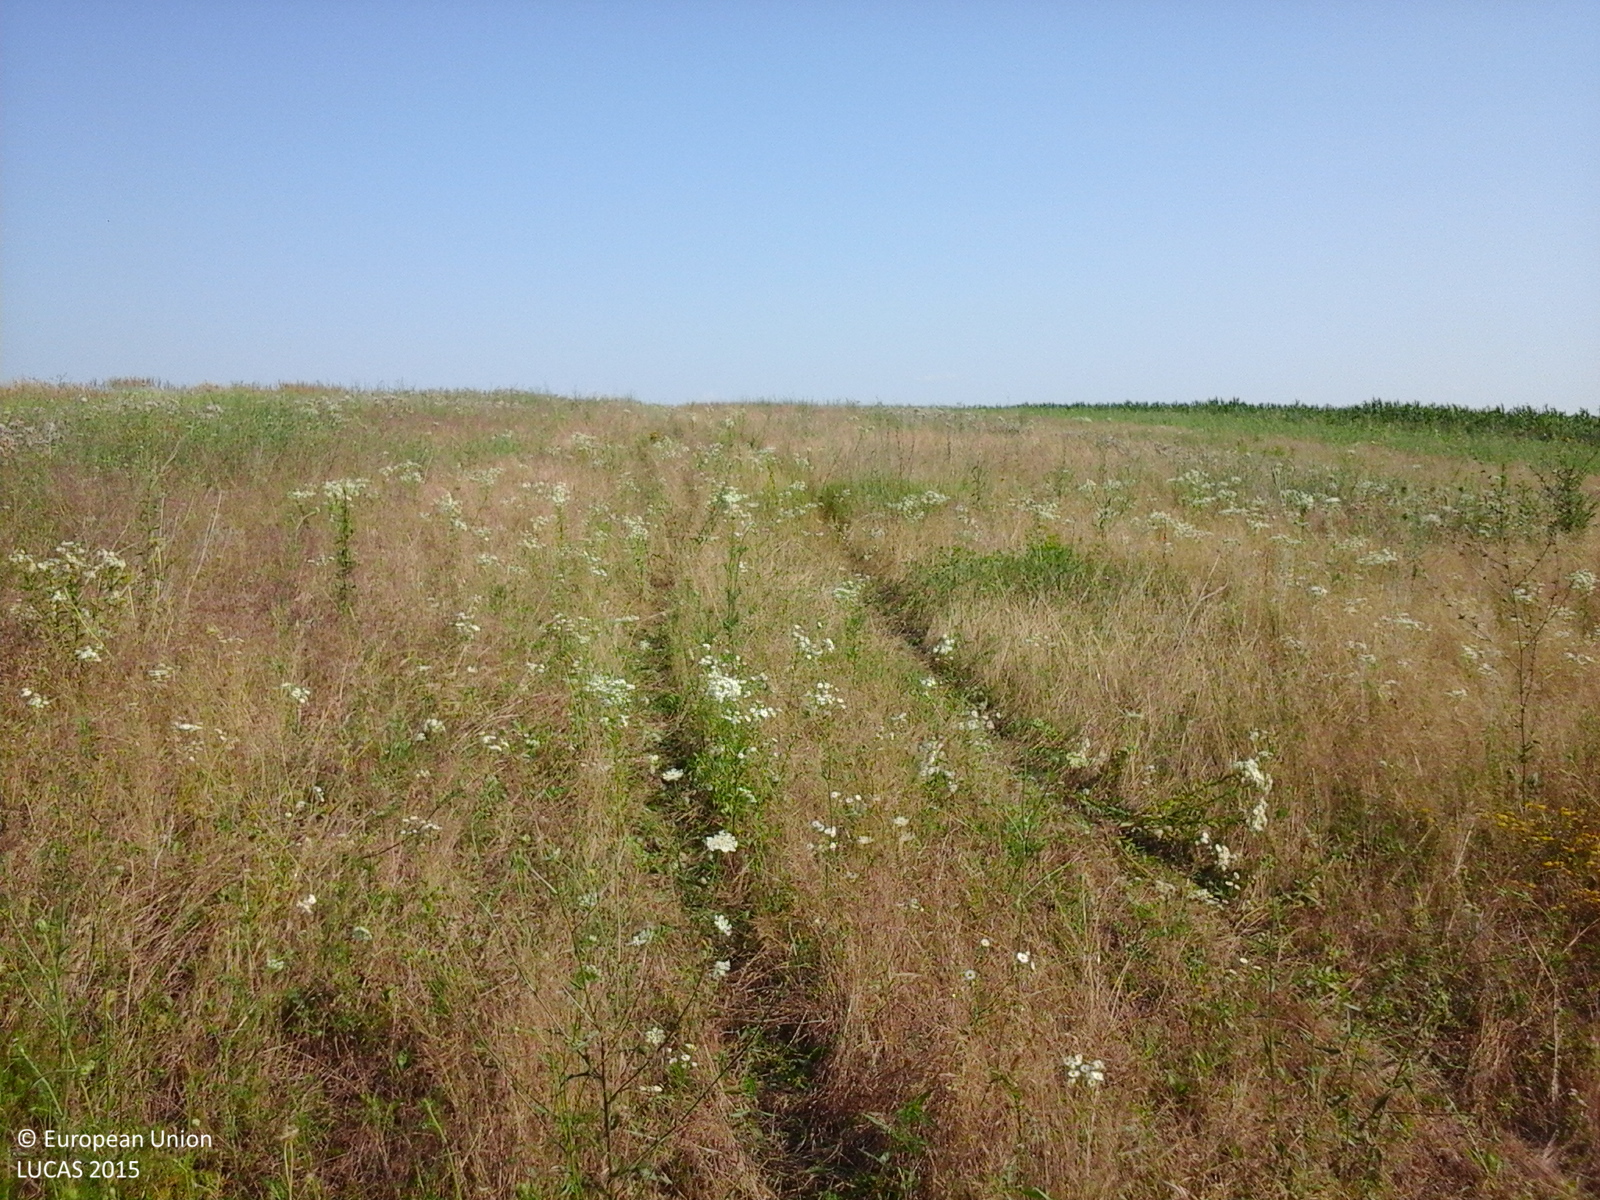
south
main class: Grassland
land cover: Spontaneously vegetated surfaces
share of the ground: > 75 %
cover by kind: herbaceous plants 100 %
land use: Fallow land
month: July
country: RO
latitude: 44.5294
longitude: 24.6585
